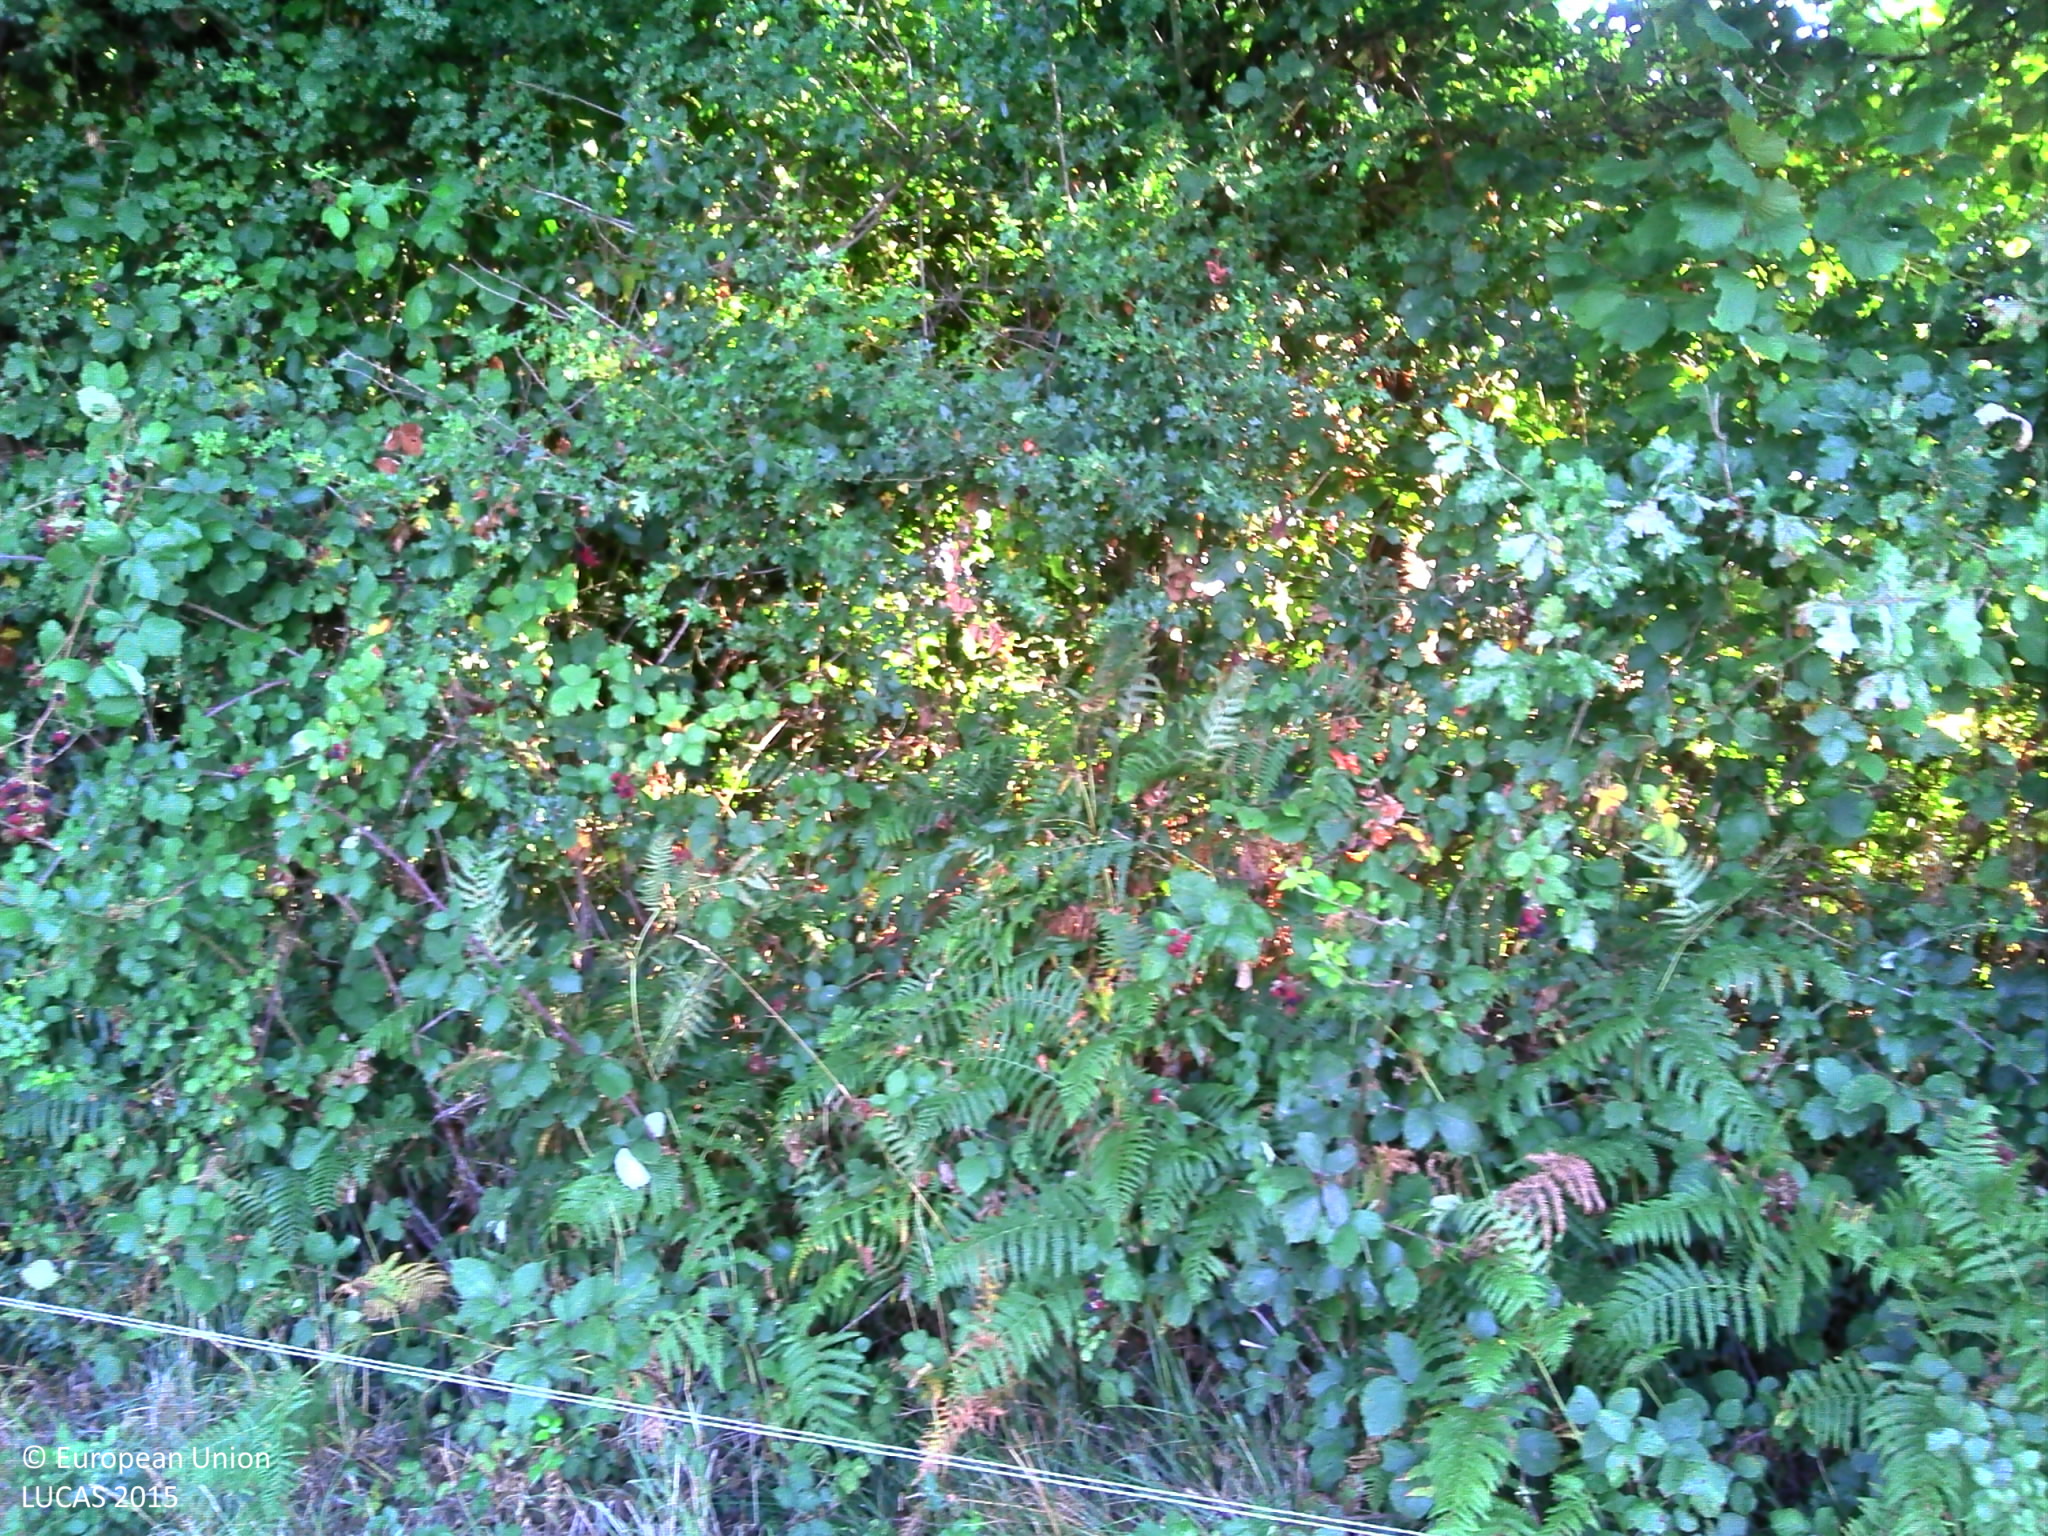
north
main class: Grassland
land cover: Grassland without tree/shrub cover
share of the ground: > 75 %
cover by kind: herbaceous plants 100 %
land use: Agriculture (excluding fallow land and kitchen gardens)
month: August
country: FR
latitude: 47.4309
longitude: -1.5644
